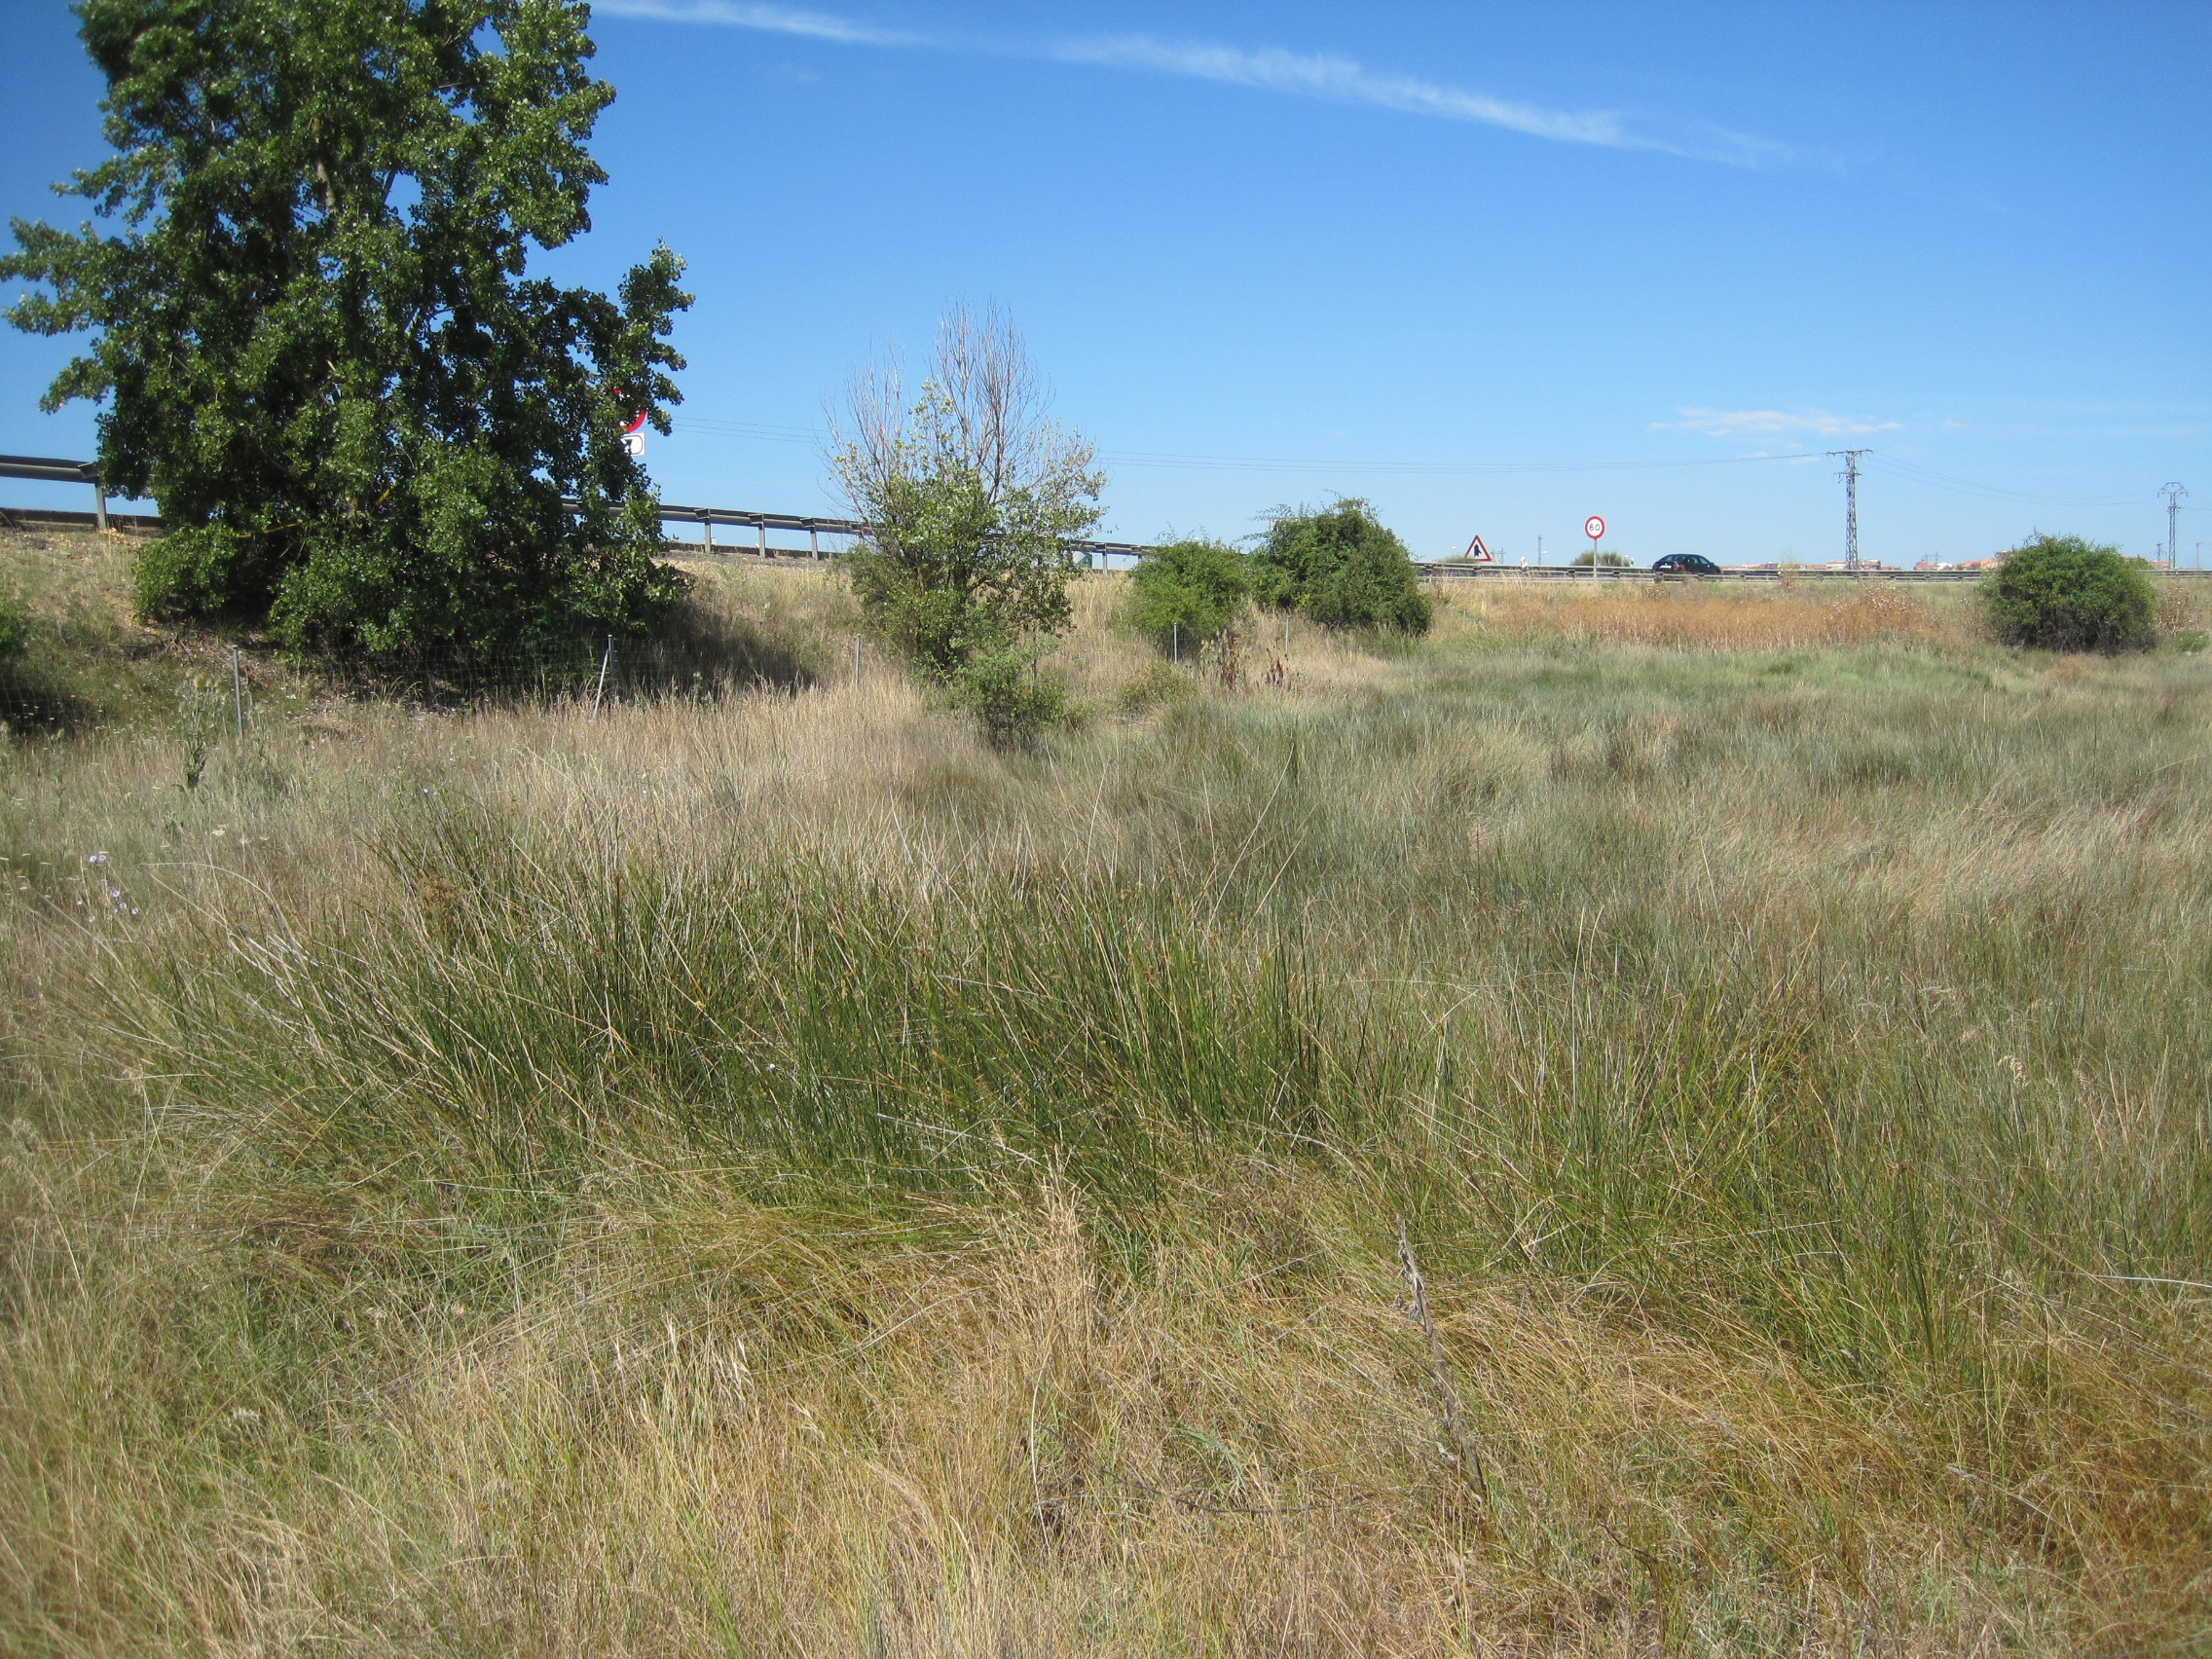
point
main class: Grassland
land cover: Grassland with sparse tree/shrub cover
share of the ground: > 75 %
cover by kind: herbaceous plants 95 %, broadleaved forest trees 5 %
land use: Semi-natural and natural areas not in use
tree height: > 5 m
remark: Temporary flooded
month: July
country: ES
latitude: 41.9976
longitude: -5.6524
